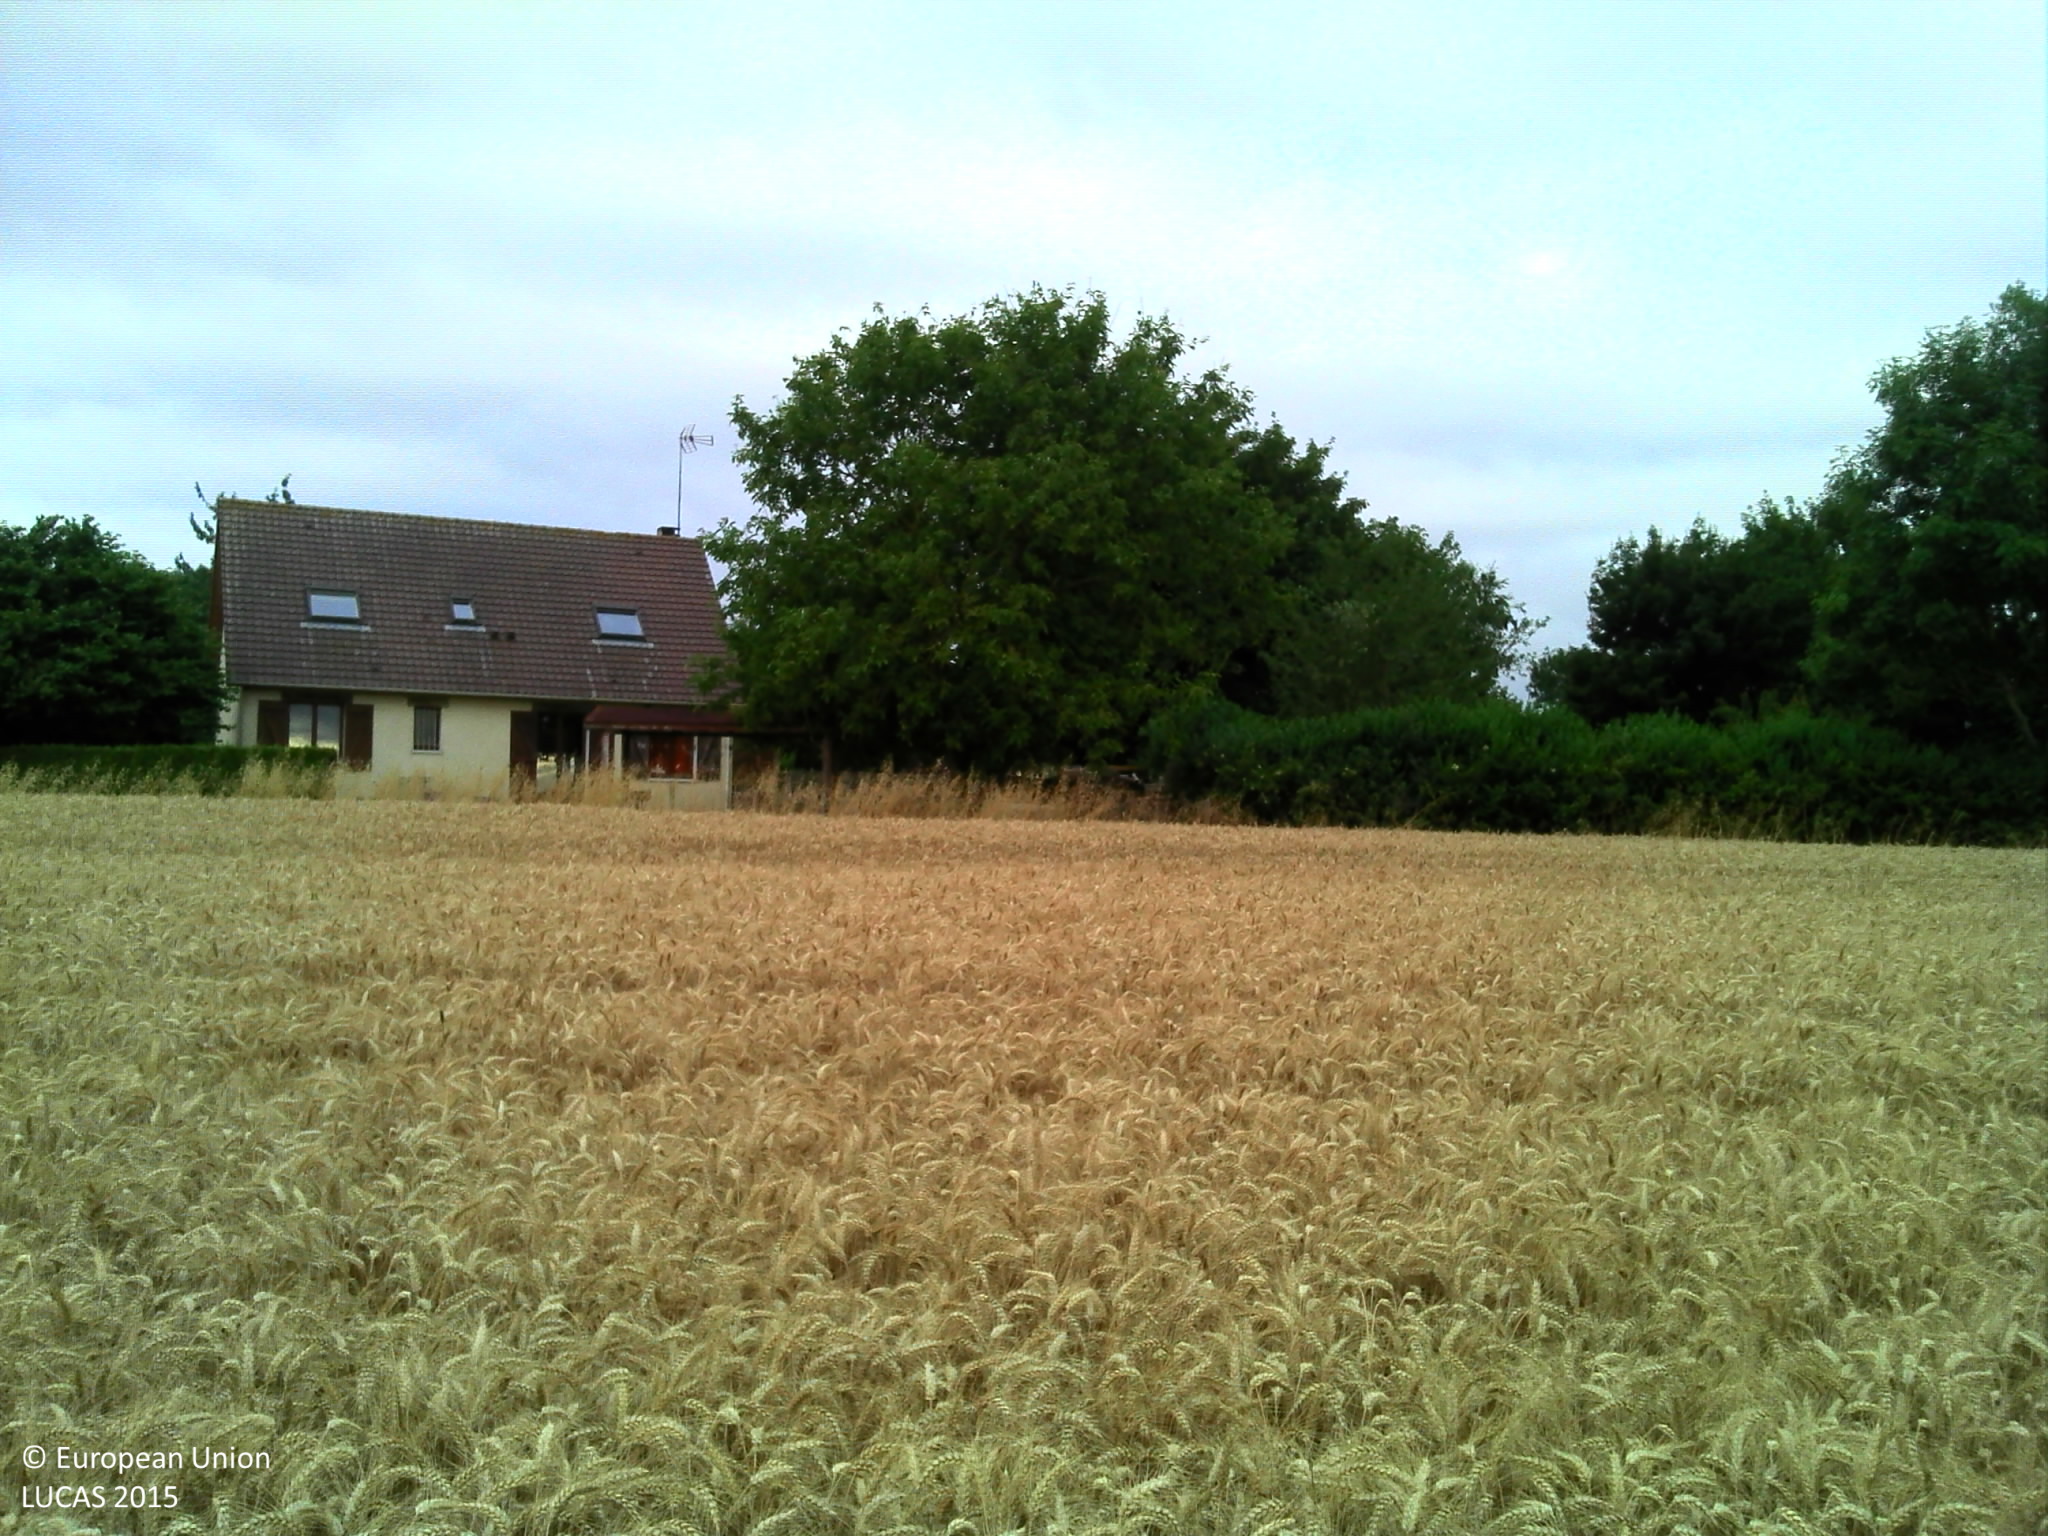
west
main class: Cropland
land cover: Common wheat
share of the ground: > 75 %
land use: Agriculture (excluding fallow land and kitchen gardens)
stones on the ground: < 10 %
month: July
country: FR
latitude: 49.0879
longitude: -0.2346
